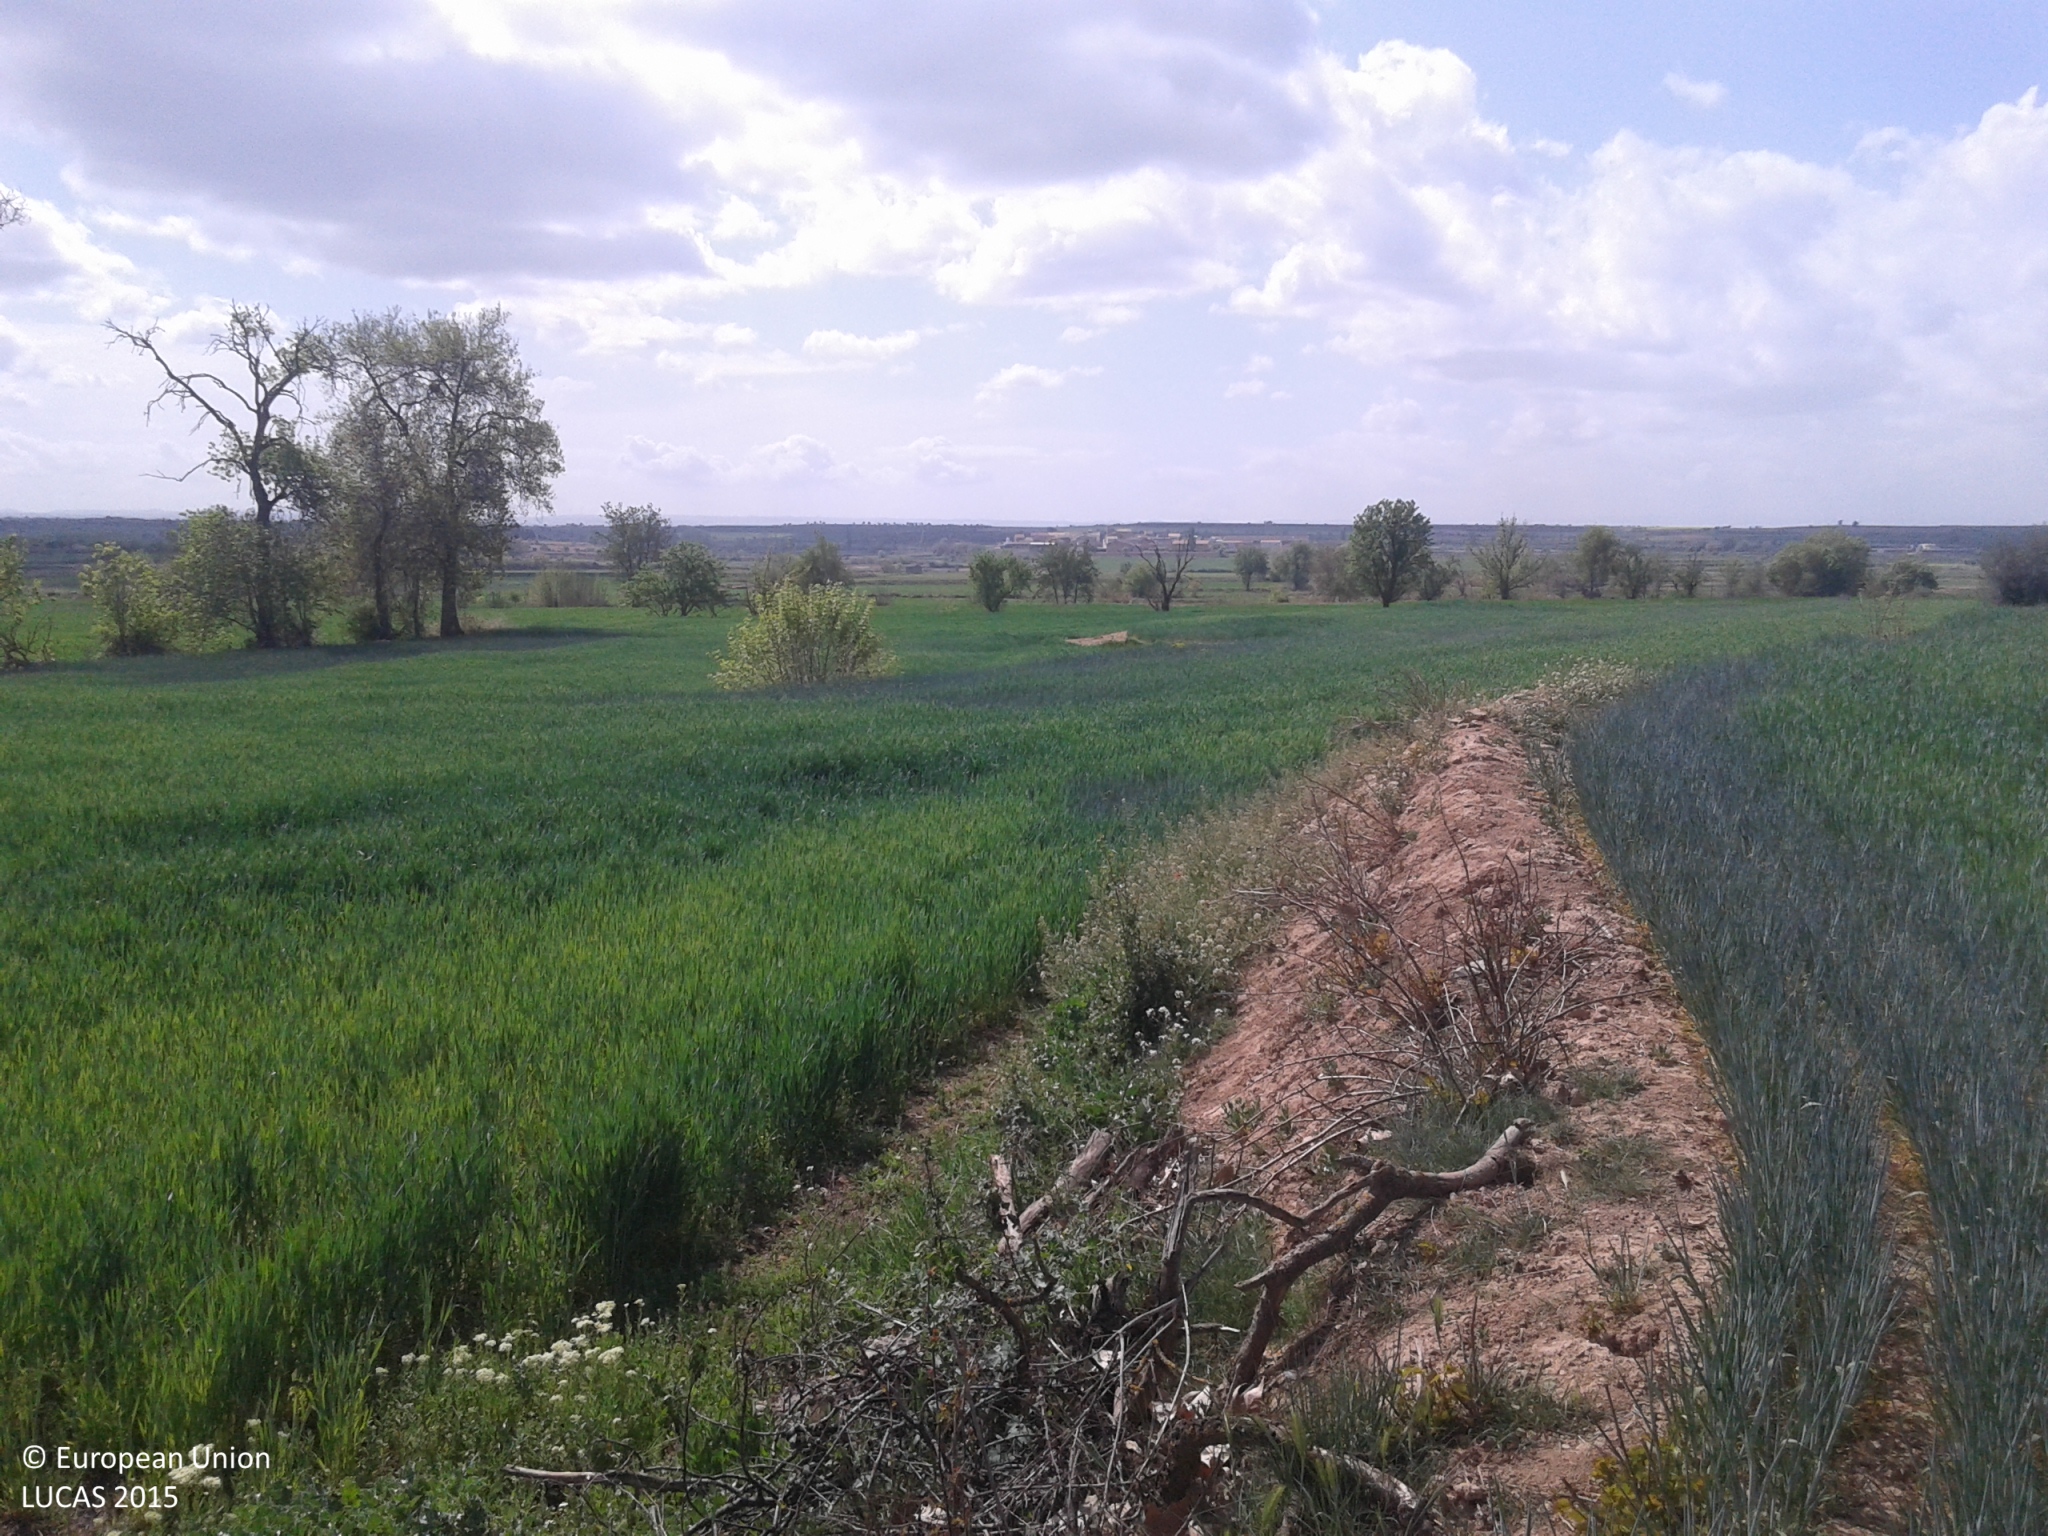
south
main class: Cropland
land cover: Oats
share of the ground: > 75 %
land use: Agriculture (excluding fallow land and kitchen gardens)
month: April
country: ES
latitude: 41.7352
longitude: 1.1037
